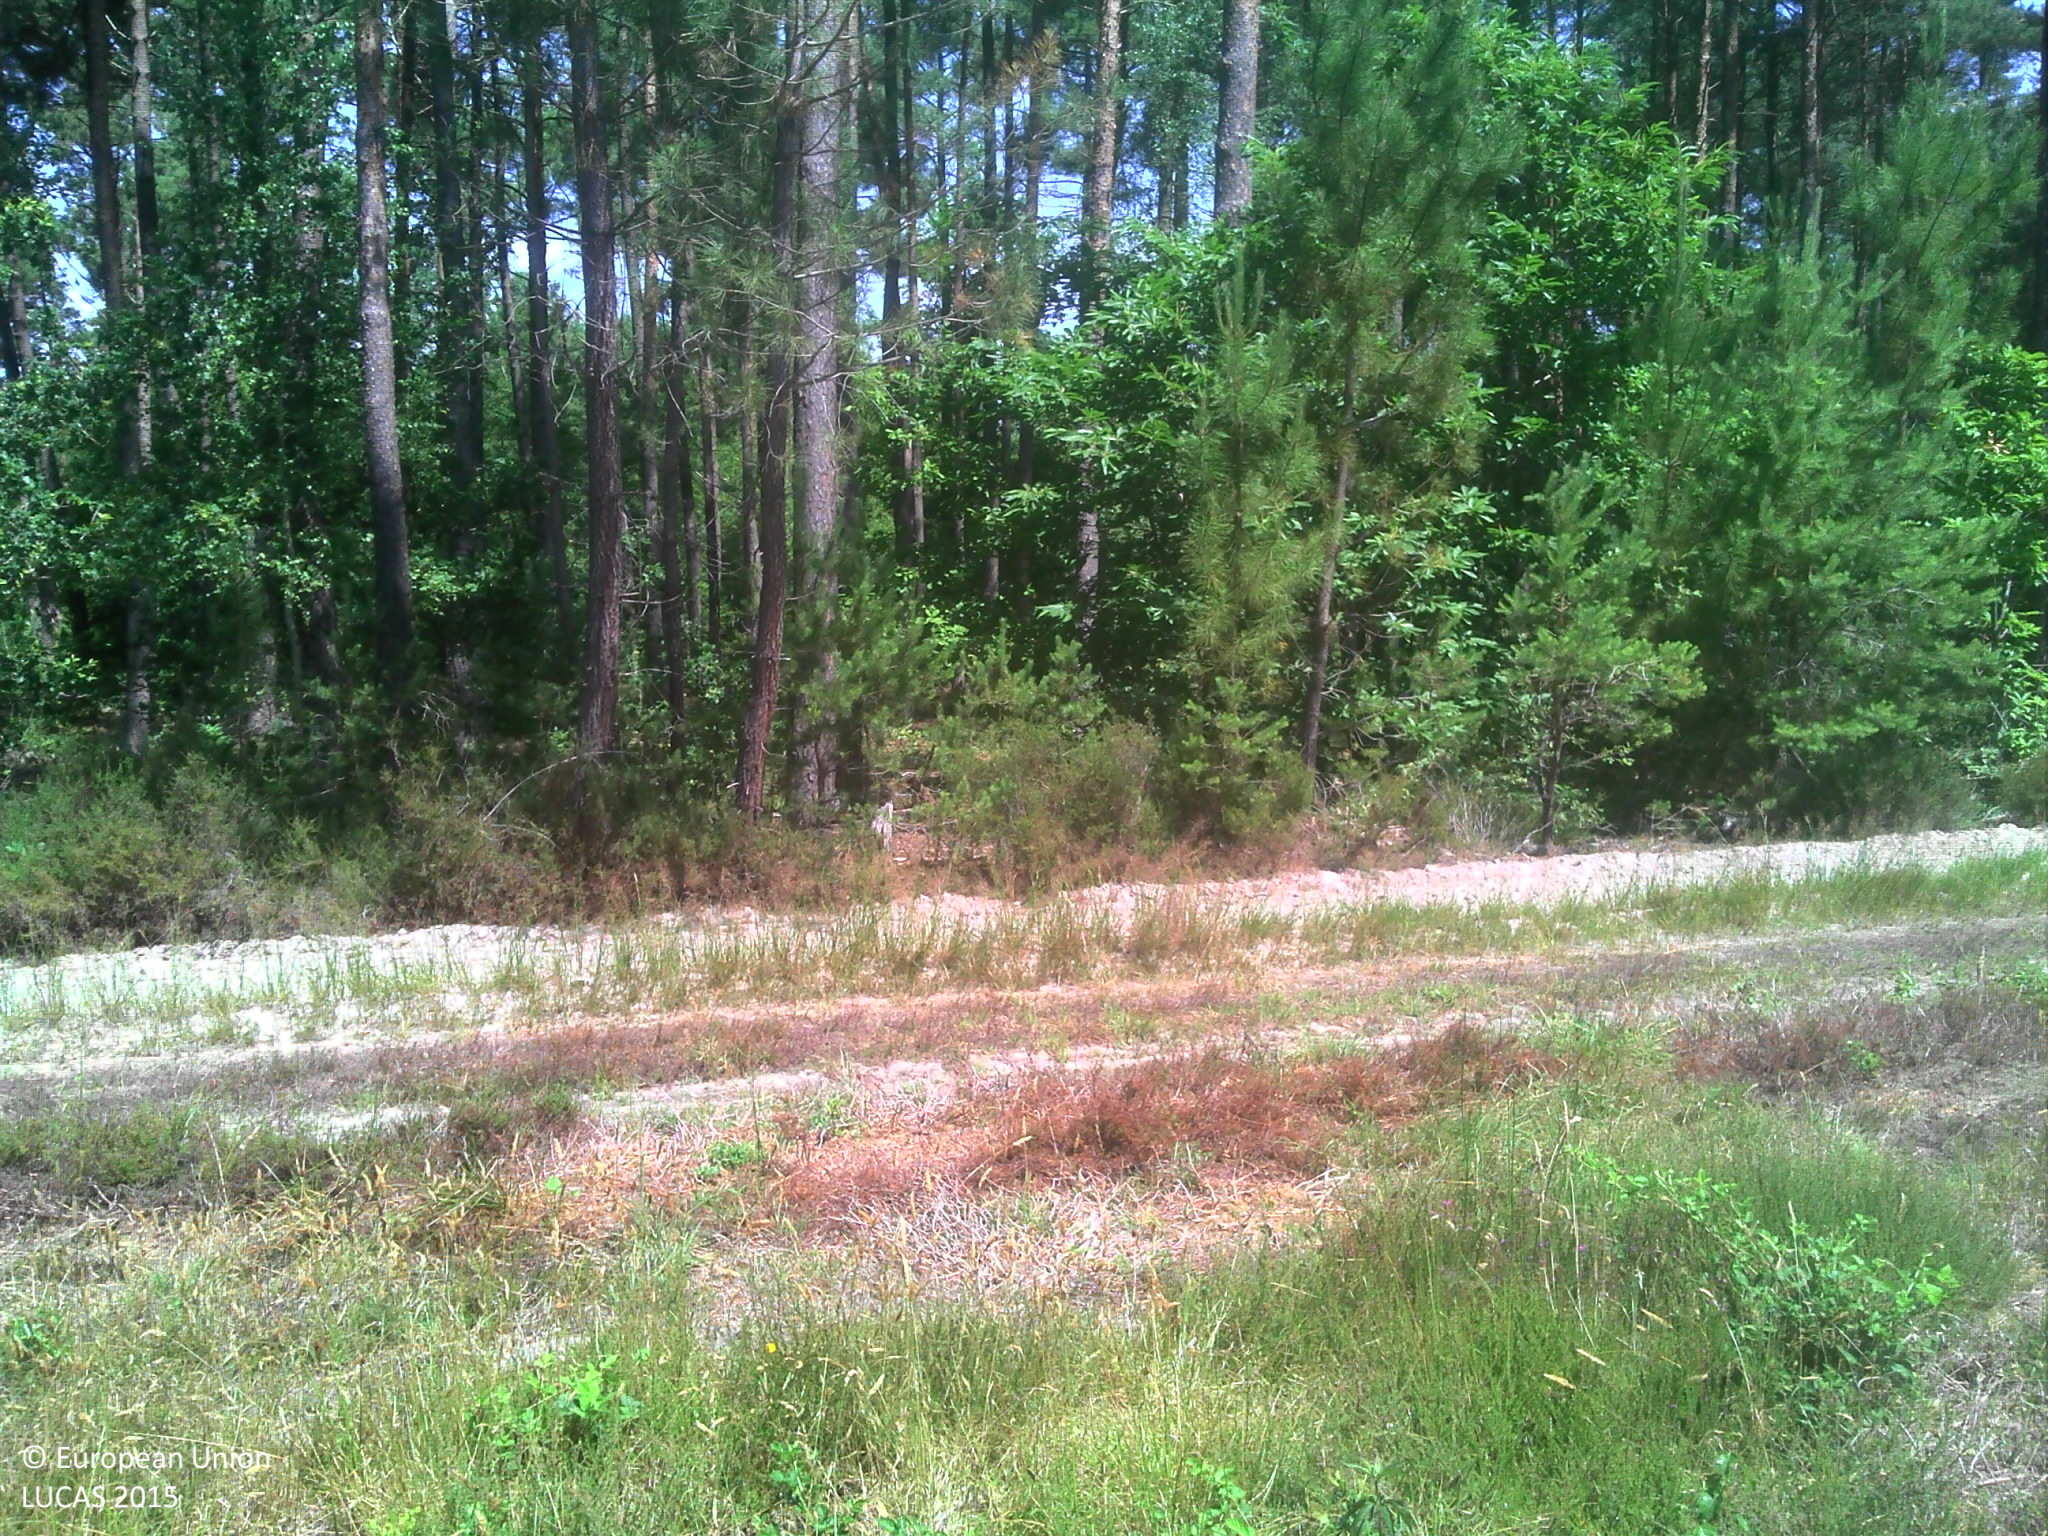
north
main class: Woodland
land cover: Pine dominated mixed woodland
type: thermophilous deciduous forest
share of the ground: > 75 %
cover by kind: unconsolidated bare surface 50 %, coniferous forest trees 30 %, broadleaved forest trees 10 %, herbaceous plants 10 %
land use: Forestry
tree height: > 5 m
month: June
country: FR
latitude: 47.3383
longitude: 1.5565
